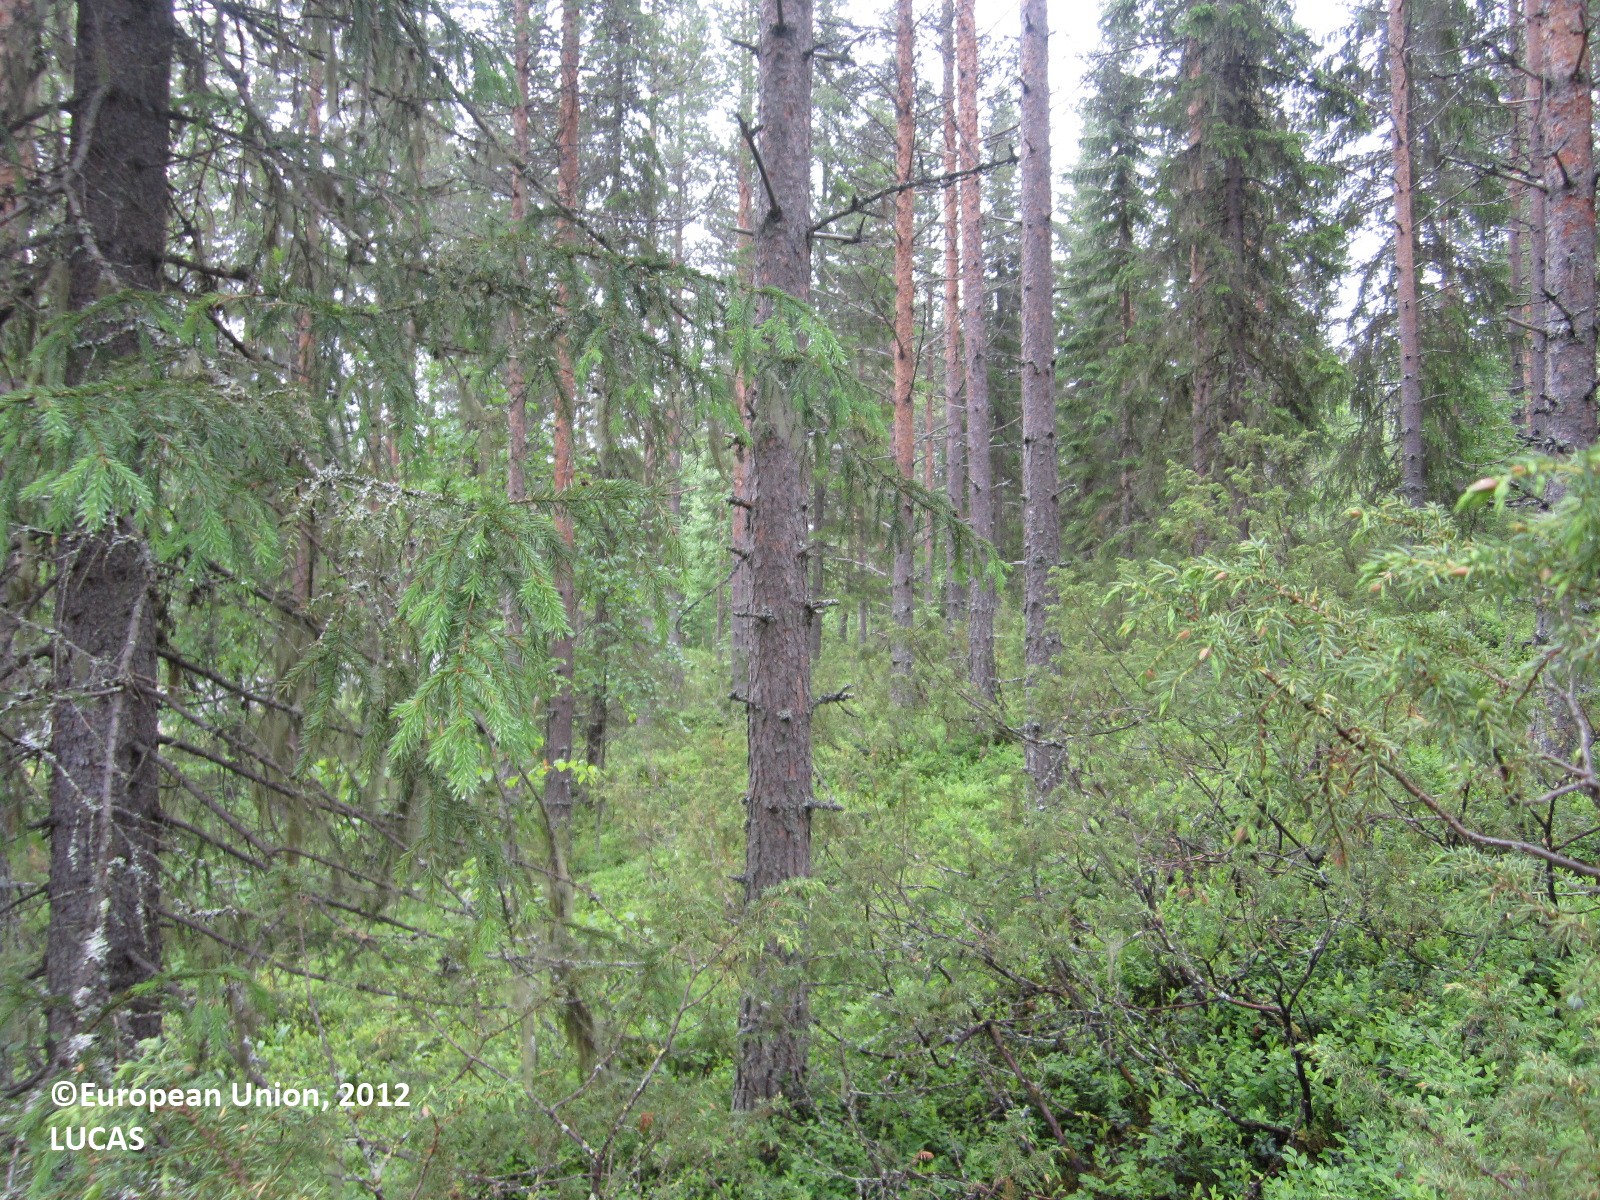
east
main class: Woodland
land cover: Other coniferous woodland
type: boreal forest
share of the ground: > 75 %
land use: Forestry
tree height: > 5 m
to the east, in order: Other coniferous woodland; Pine dominated coniferous woodland; Tracks; Pine dominated coniferous woodland; Paved roads, cycling and walking lanes; Ditches and canals; Spontaneously vegetated surfaces; Paved roads, cycling and walking lanes; Spontaneously vegetated surfaces; Pine dominated mixed woodland; Ditches and canals; Abandoned hedges; Spontaneously vegetated surfaces; Grassland without tree/shrub cover
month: June
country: FI
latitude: 64.5542
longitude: 29.2044
